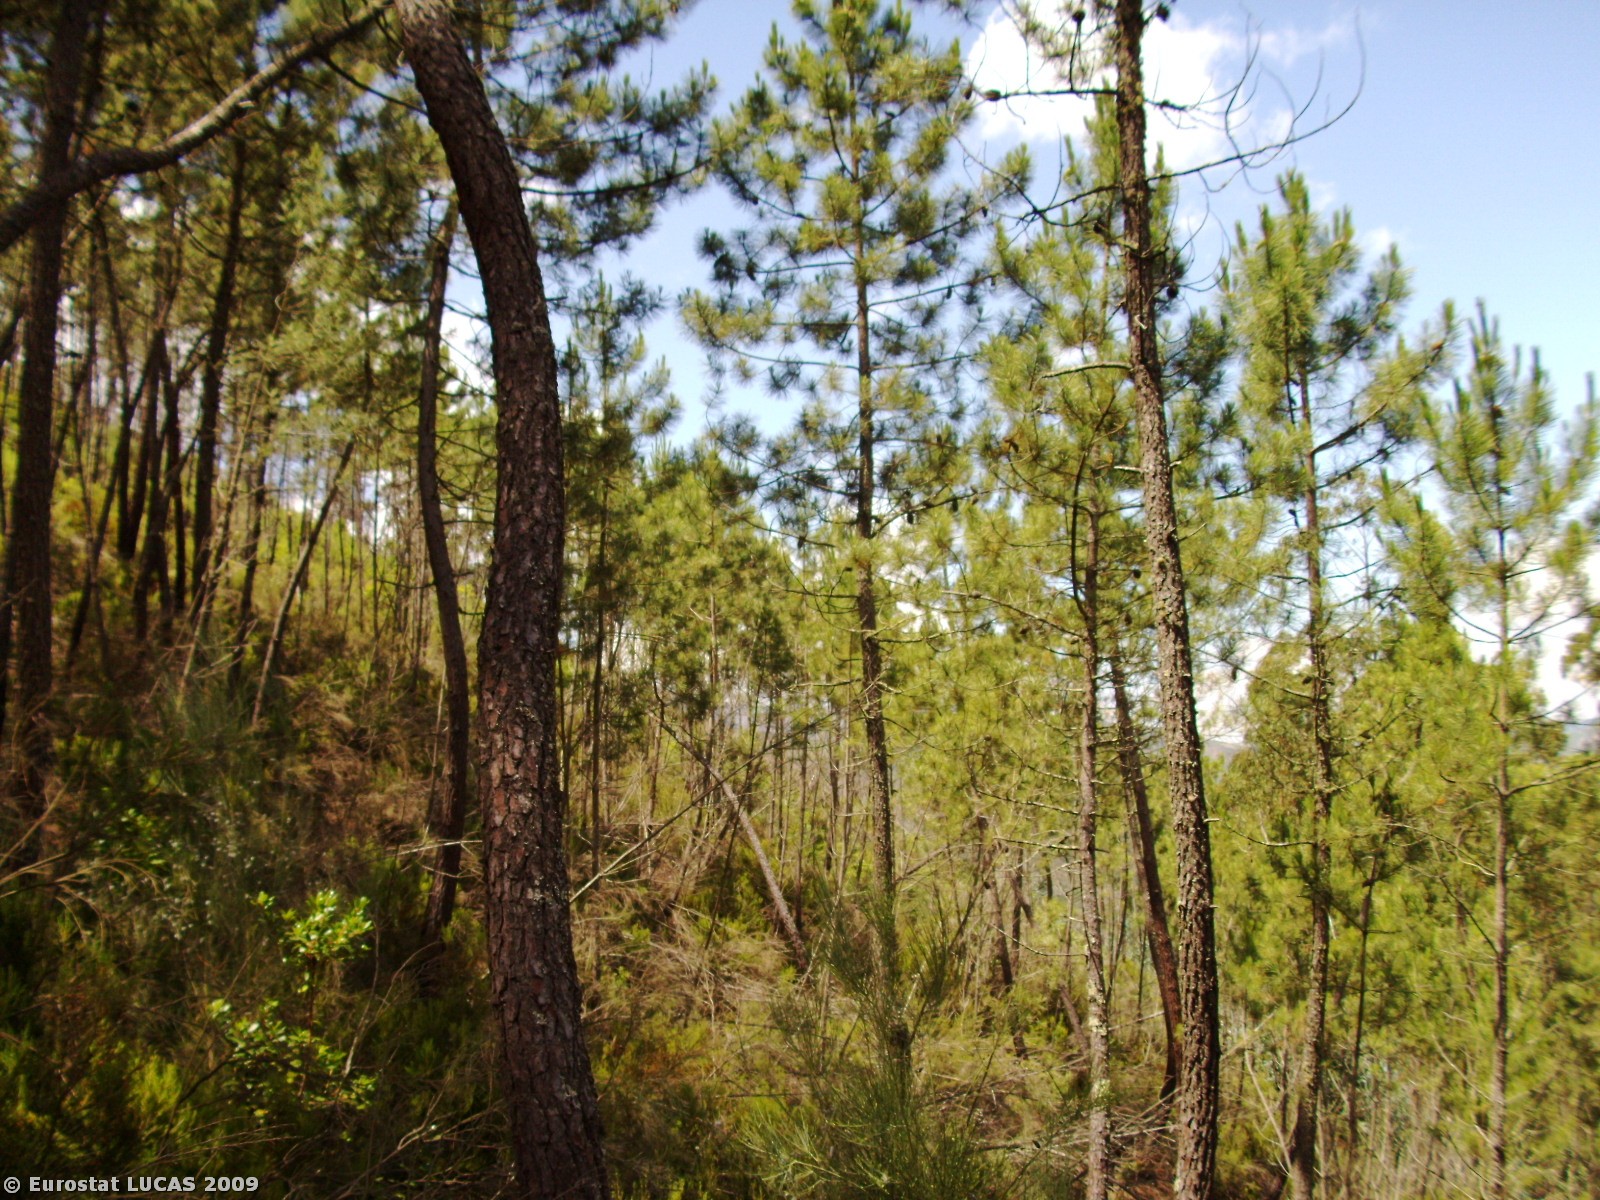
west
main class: Woodland
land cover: Coniferous woodland
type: coniferous forest of the mediterranean region
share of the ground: > 75 %
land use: Forestry
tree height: > 5 m
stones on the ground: 25 - 50 %
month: June
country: PT
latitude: 40.2832
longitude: -7.7206
